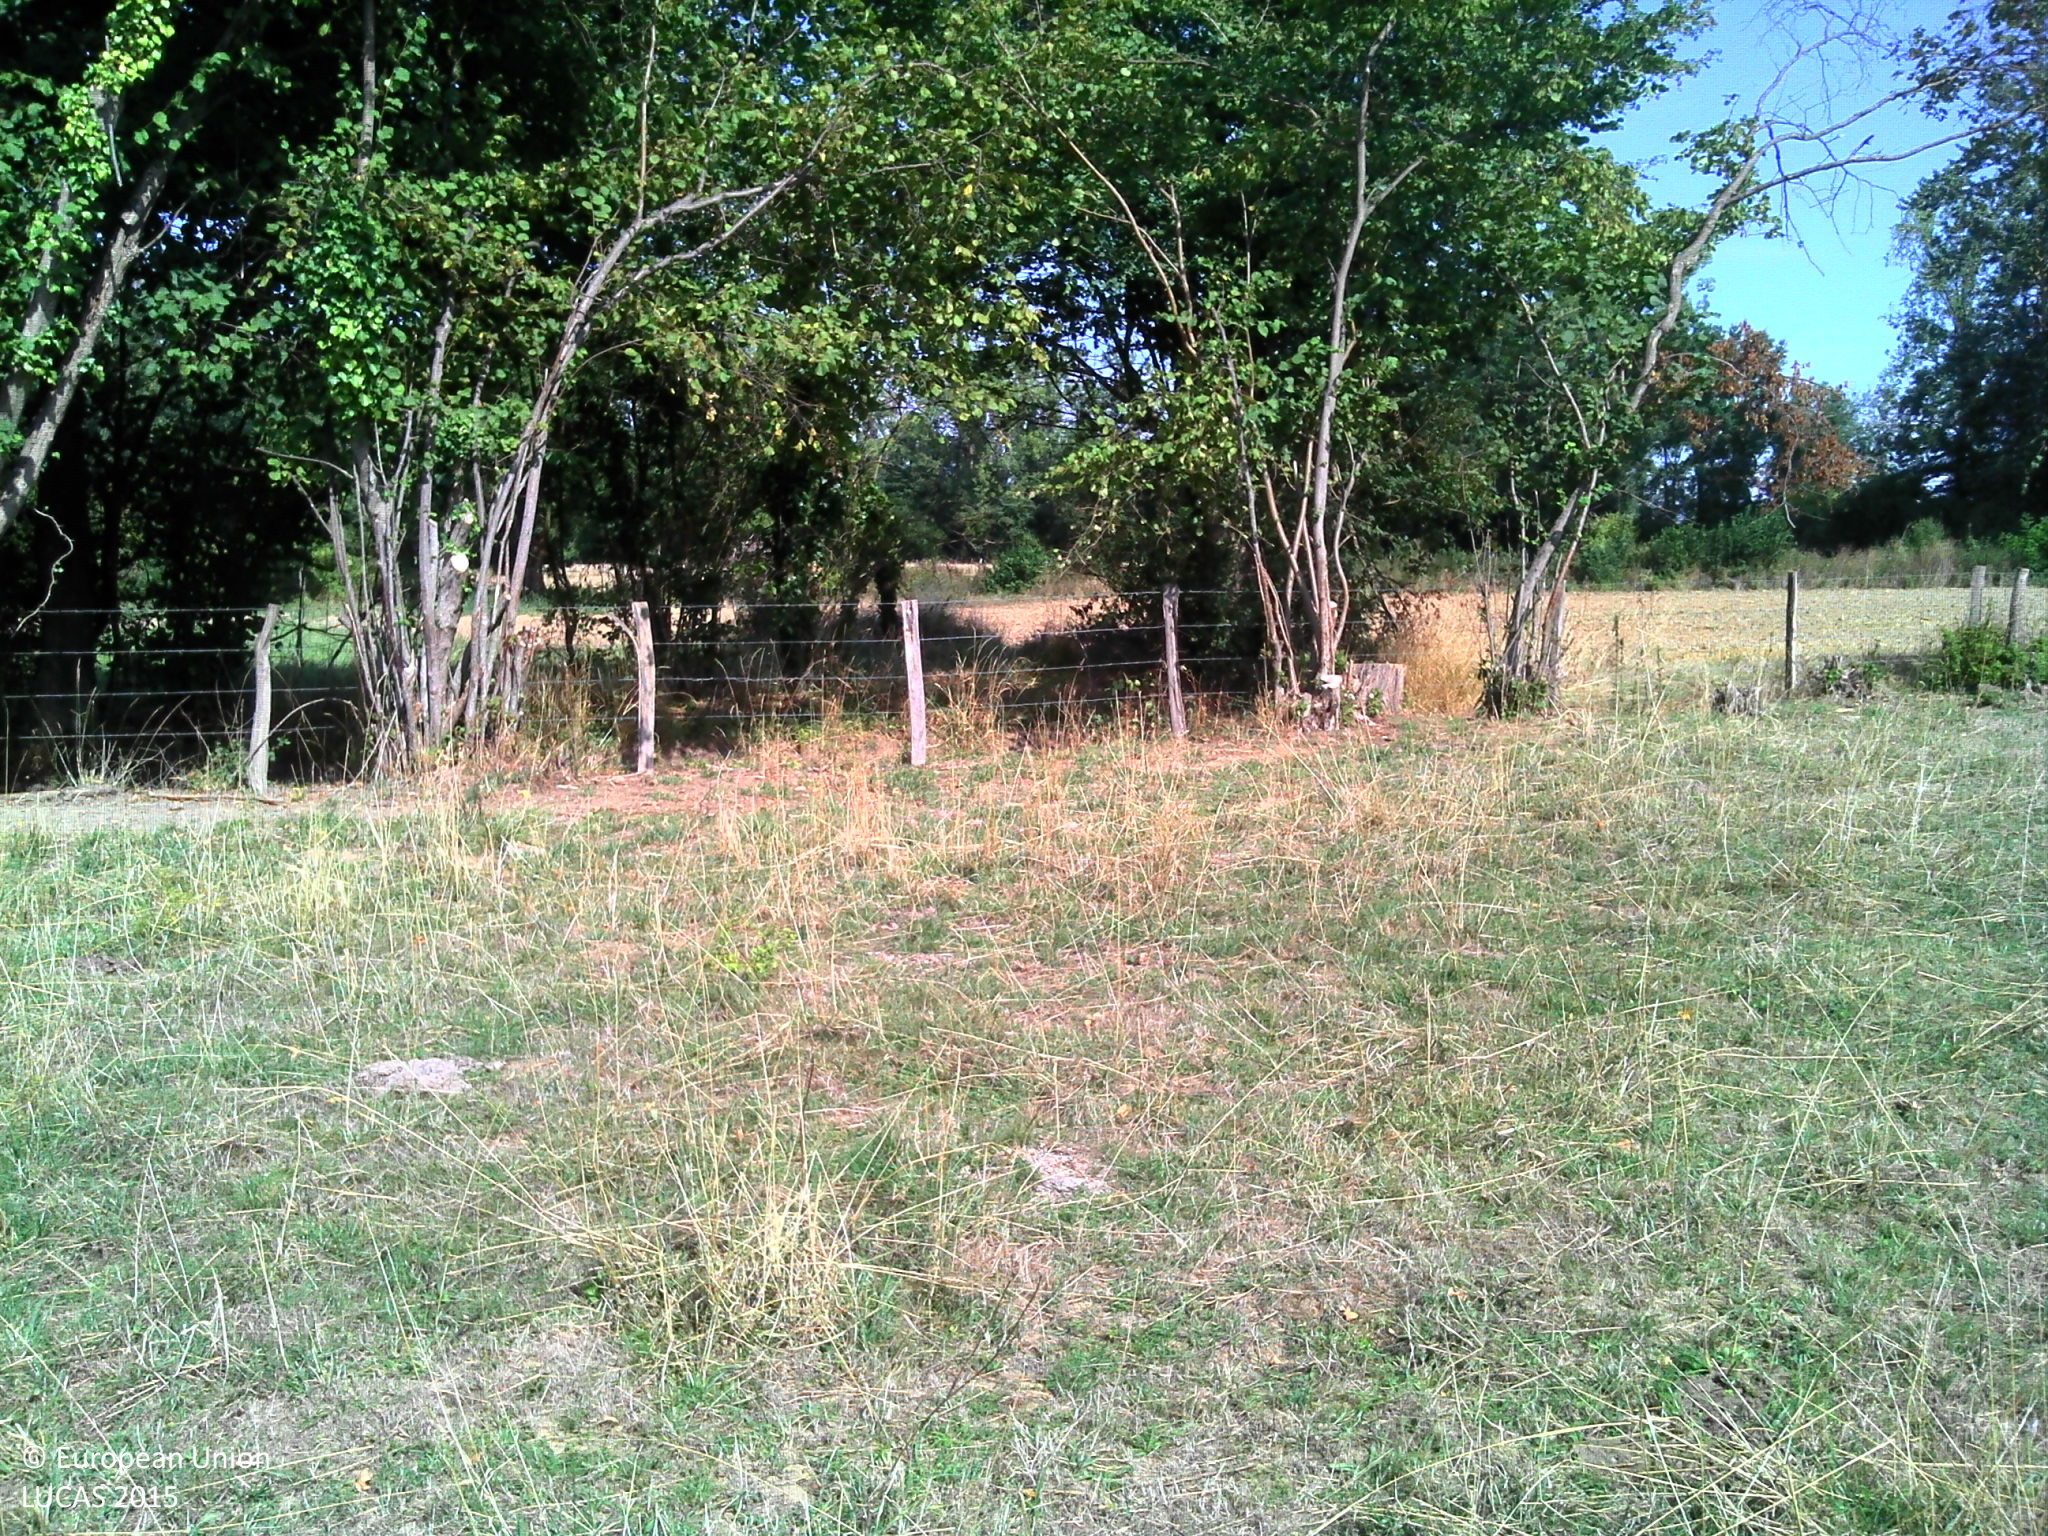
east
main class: Grassland
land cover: Grassland without tree/shrub cover
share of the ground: > 75 %
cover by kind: herbaceous plants 100 %
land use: Agriculture (excluding fallow land and kitchen gardens)
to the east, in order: Grassland without tree/shrub cover; Lines of trees; Fences; Tracks; Lines of trees; Common wheat; Abandoned hedges; Common wheat; Fences; Grassland without tree/shrub cover; Fences; Lines of trees; Rivers and streams; Lines of trees
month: August
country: FR
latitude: 46.0556
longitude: 4.6644
